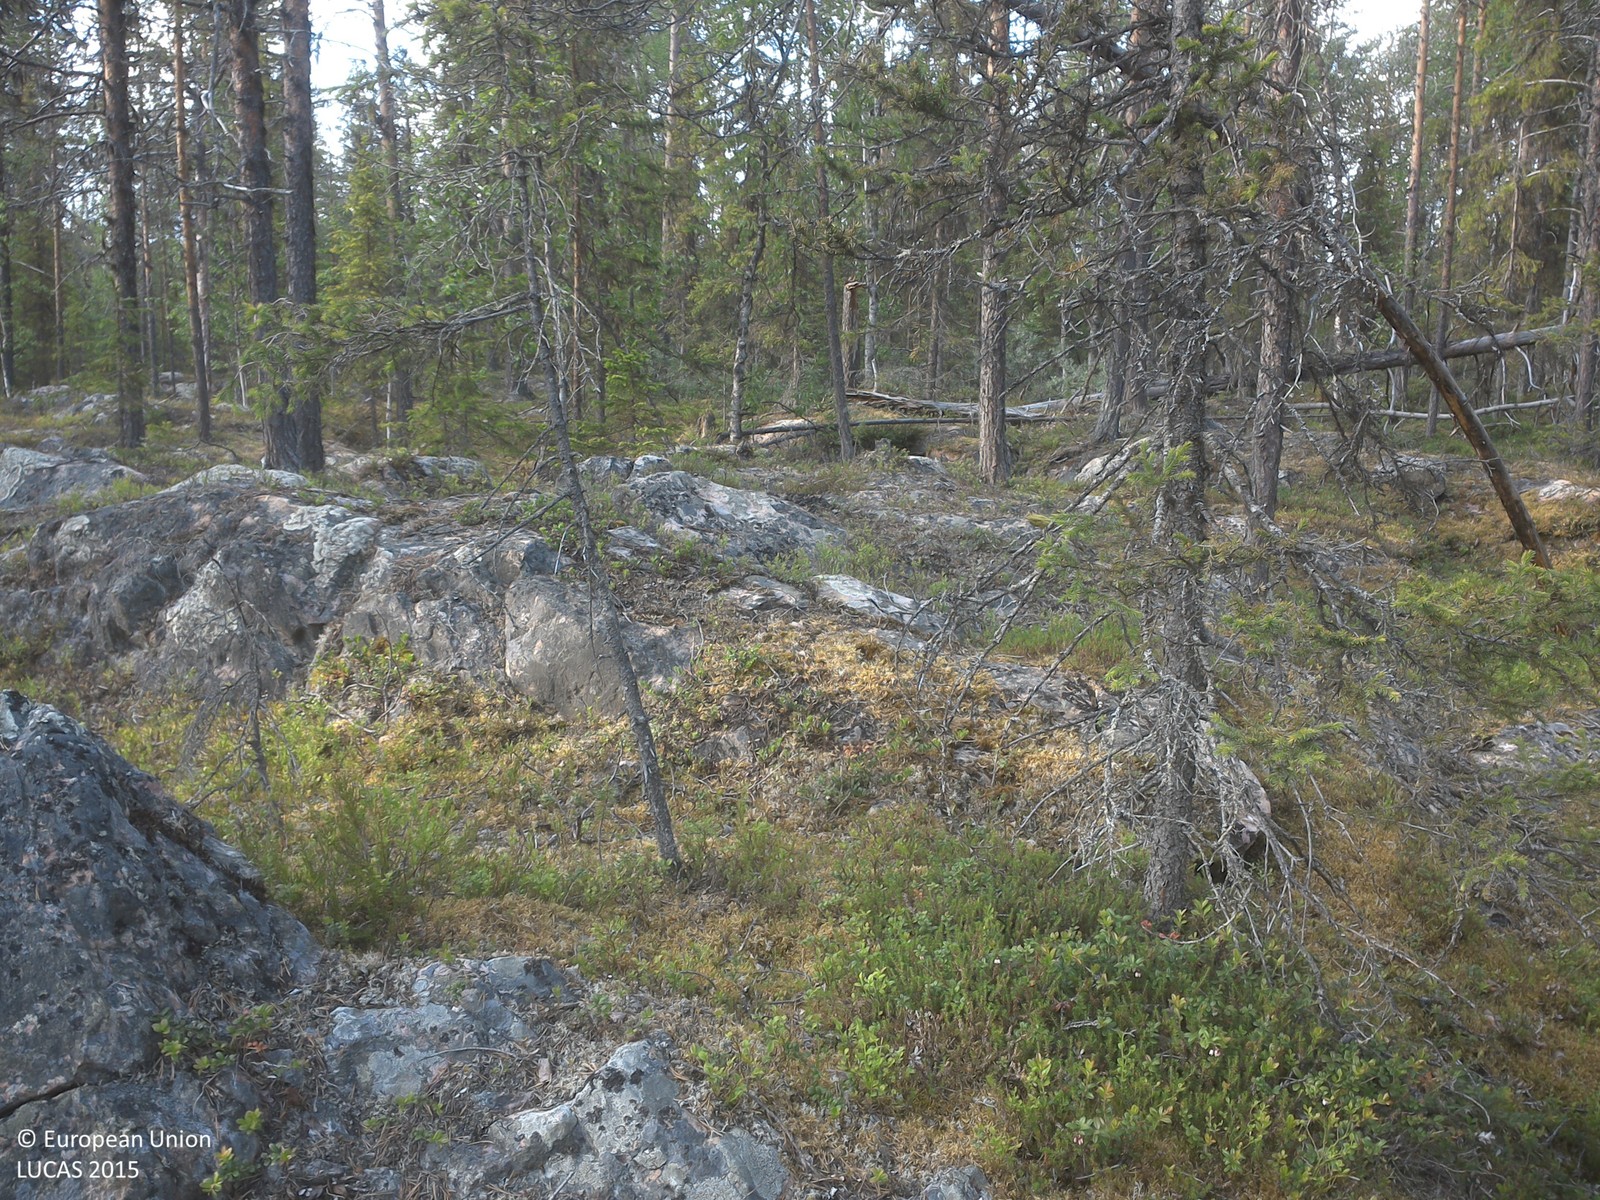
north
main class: Woodland
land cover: Pine dominated mixed woodland
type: boreal forest
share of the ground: 10 - 25 %
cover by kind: lichens and mosses 50 %, shrubs 25 %, coniferous forest trees 15 %, broadleaved forest trees 5 %, consolidated bare surface 5 %
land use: Forestry
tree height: > 5 m
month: July
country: SE
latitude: 67.4559
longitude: 23.1242
